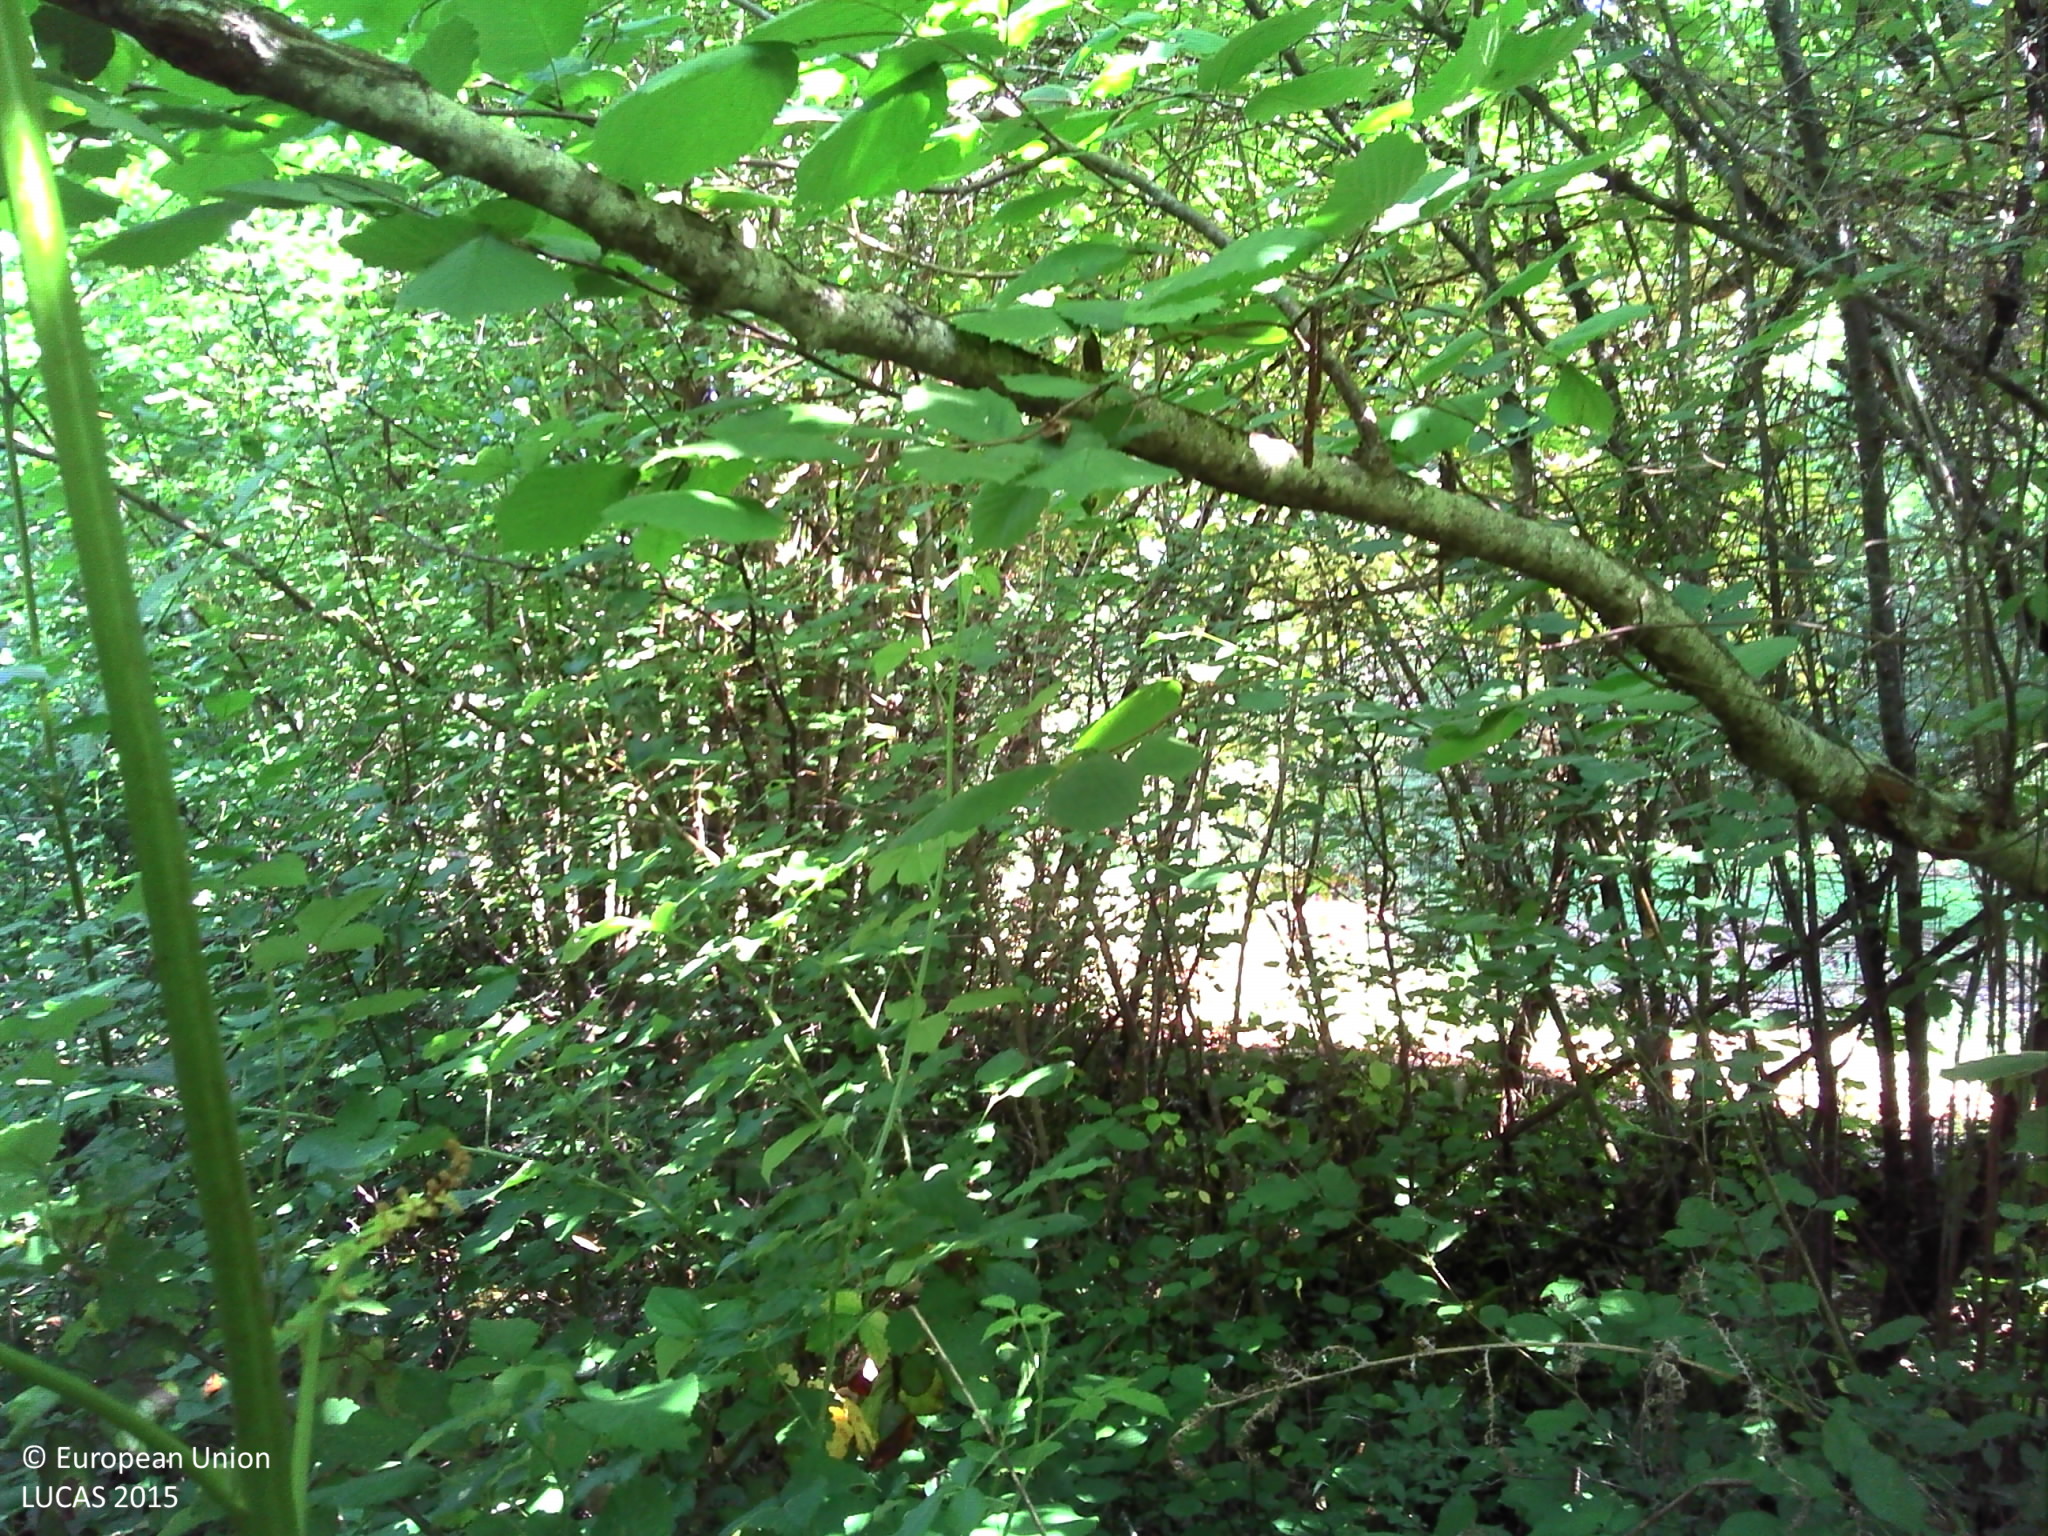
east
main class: Woodland
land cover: Broadleaved woodland
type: mesophytic deciduous forest
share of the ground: > 75 %
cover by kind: broadleaved forest trees 80 %, herbaceous plants 15 %, shrubs 5 %
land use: Forestry
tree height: > 5 m
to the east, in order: Broadleaved woodland; Grassland with sparse tree/shrub cover
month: June
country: FR
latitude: 45.6085
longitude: 0.3817
